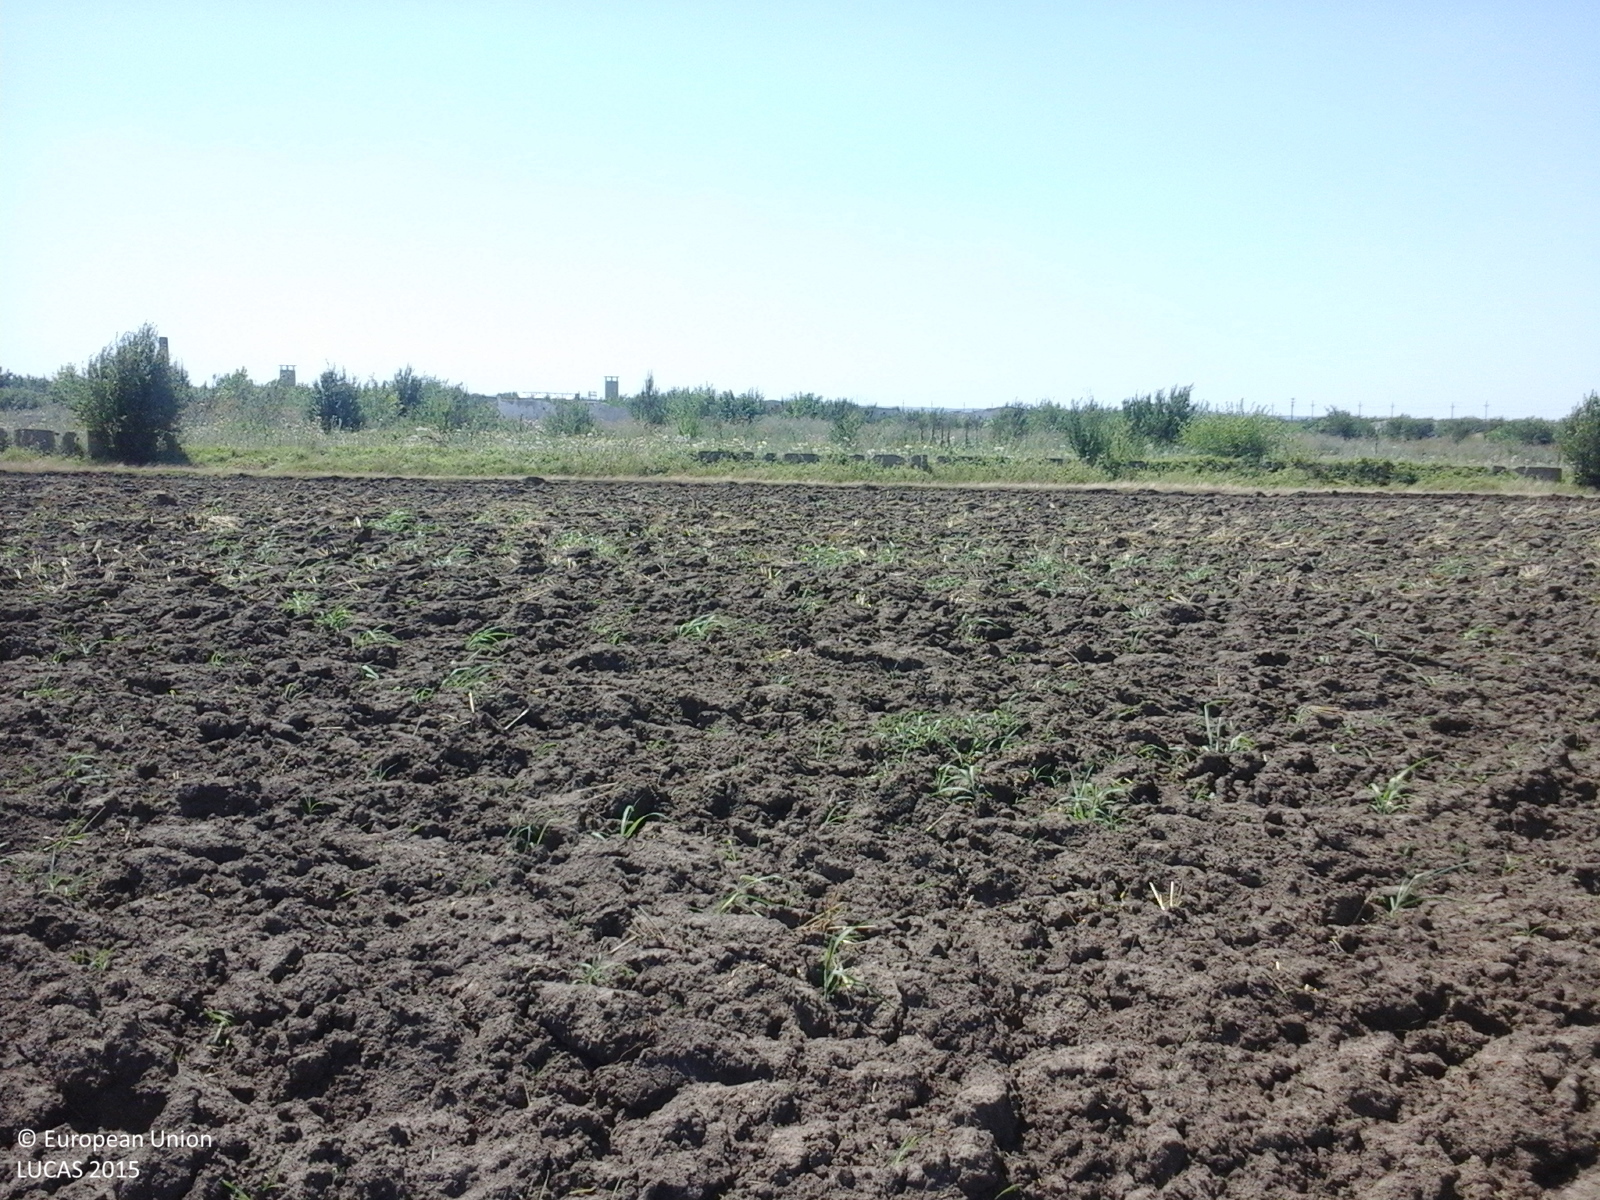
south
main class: Cropland
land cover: Durum wheat
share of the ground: < 10 %
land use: Agriculture (excluding fallow land and kitchen gardens)
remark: Harvested field
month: July
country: RO
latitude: 44.1295
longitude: 26.6762
